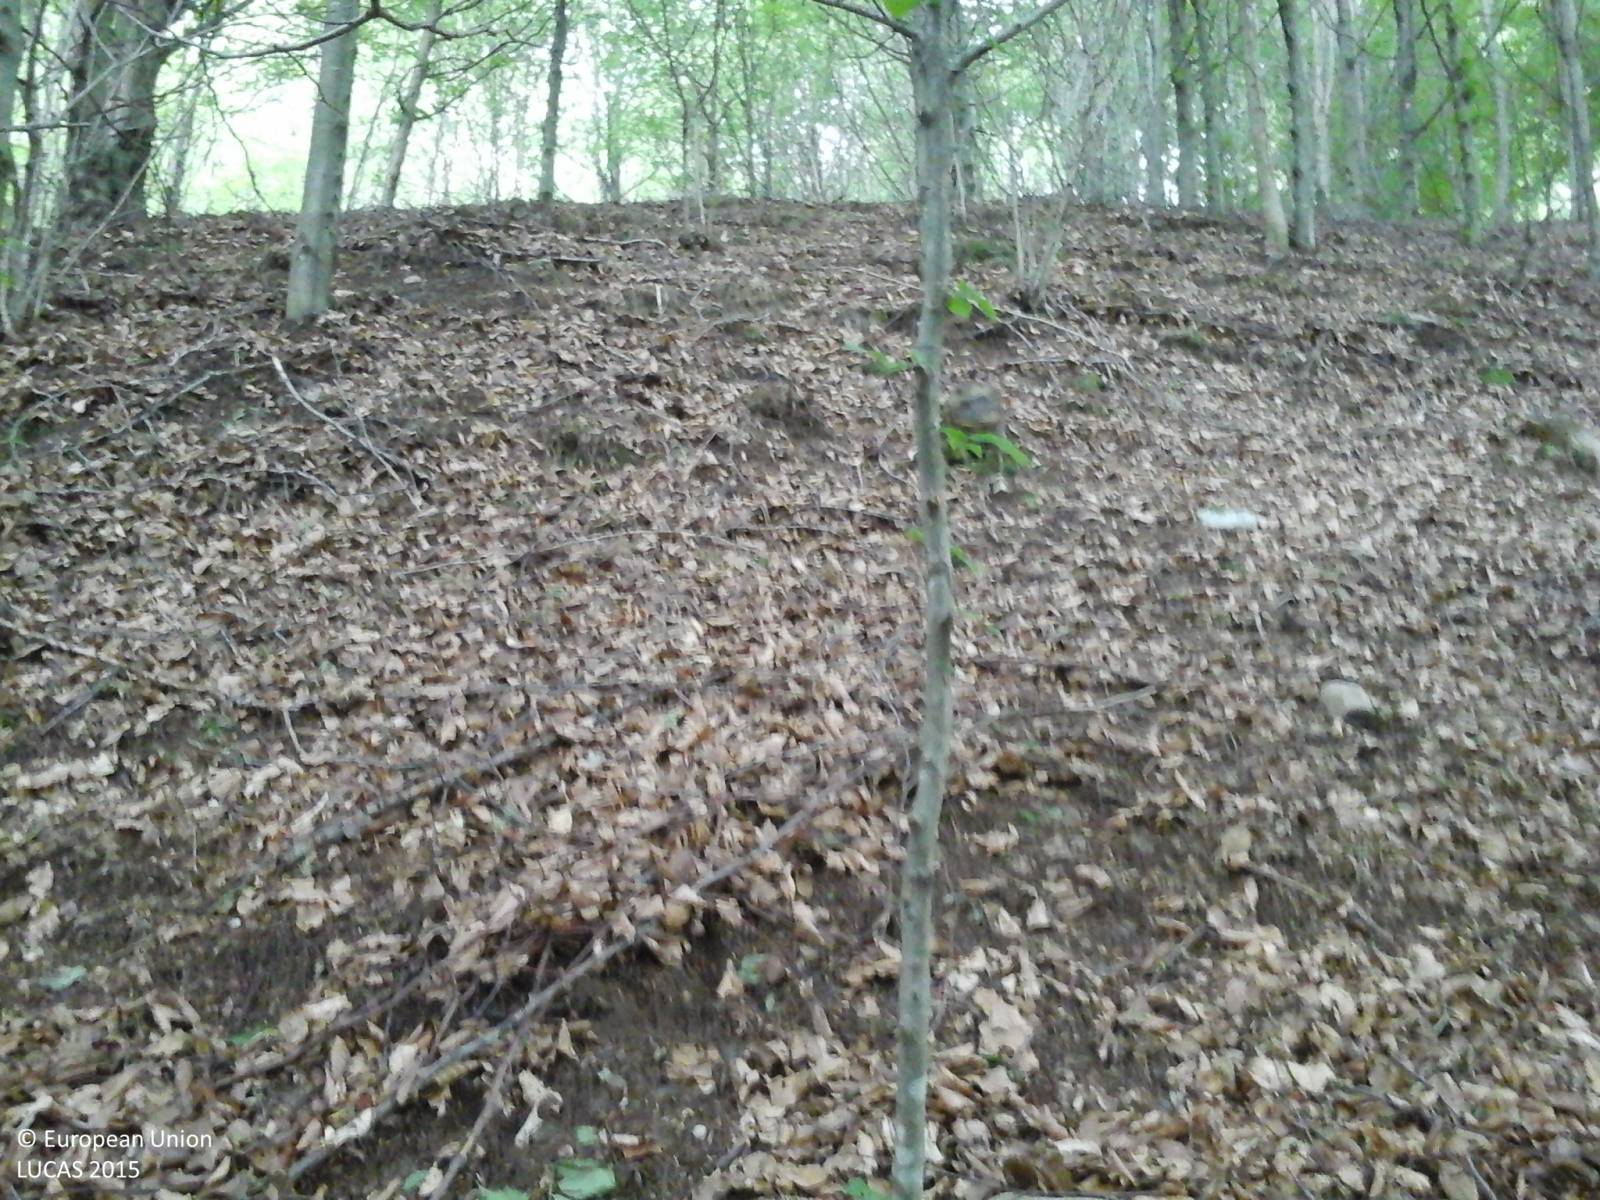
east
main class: Woodland
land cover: Broadleaved woodland
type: mountainous beech forest
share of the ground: > 75 %
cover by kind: broadleaved forest trees 95 %, coniferous forest trees 5 %
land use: Forestry
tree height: > 5 m
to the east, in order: Broadleaved woodland; Other mixed woodland; Inland fresh running water; Broadleaved woodland; Paved roads, cycling and walking lanes; Broadleaved woodland
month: June
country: IT
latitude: 46.1797
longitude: 12.4195
